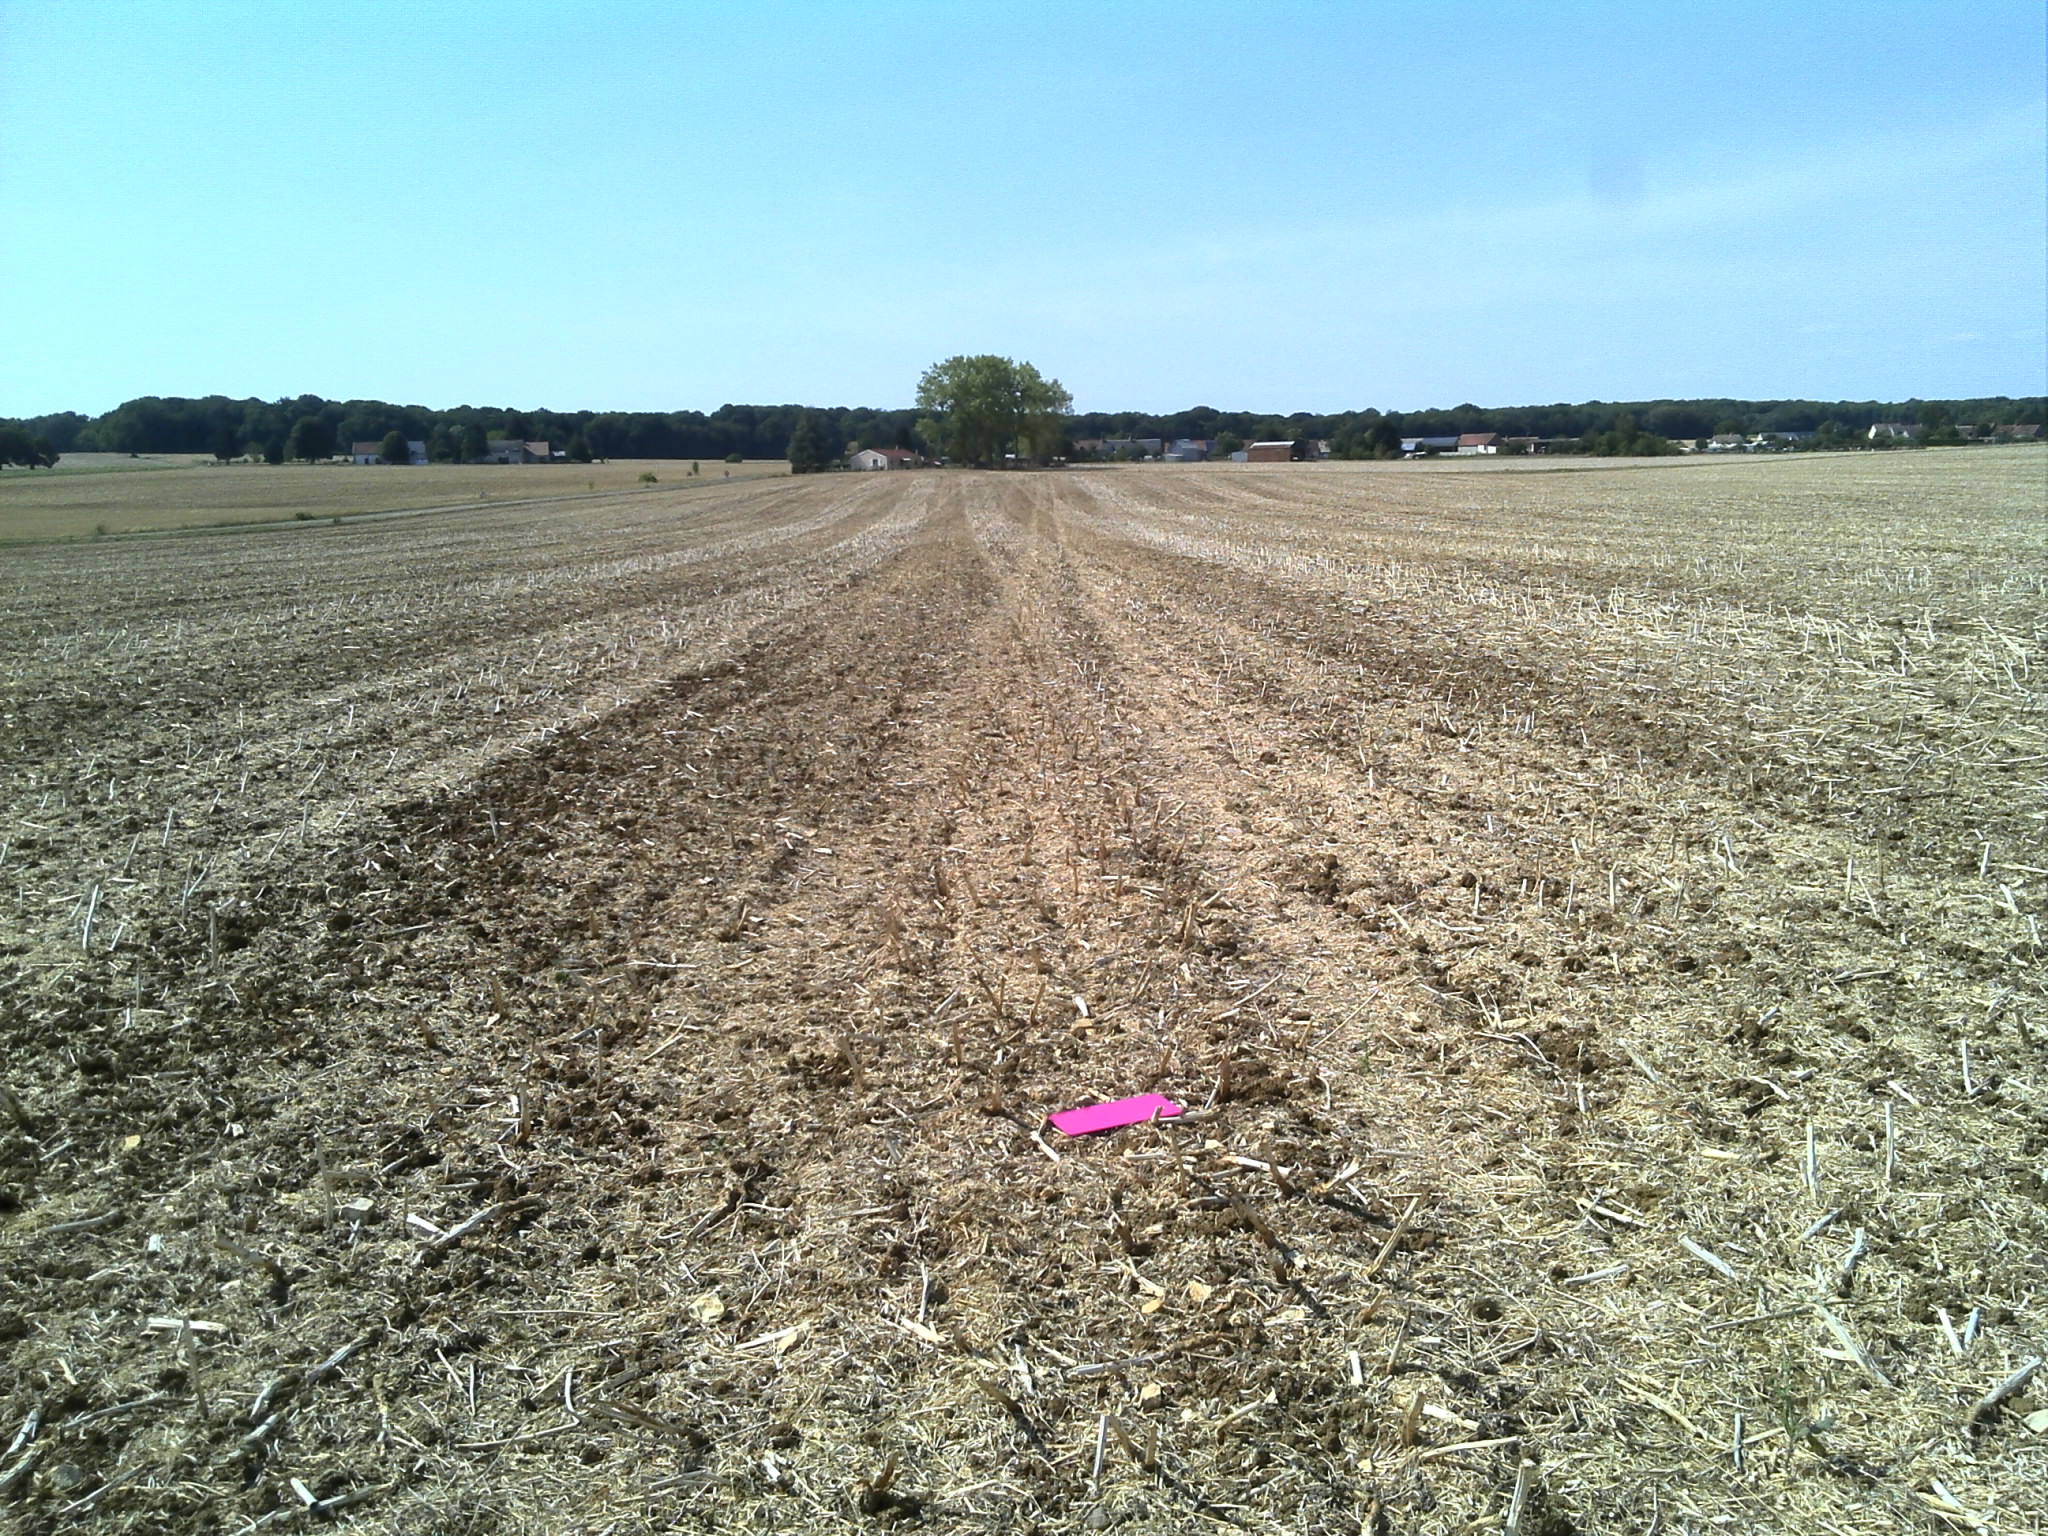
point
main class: Cropland
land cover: Rape and turnip rape
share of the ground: < 10 %
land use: Agriculture (excluding fallow land and kitchen gardens)
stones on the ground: < 10 %
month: August
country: FR
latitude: 46.9032
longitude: 1.5475
